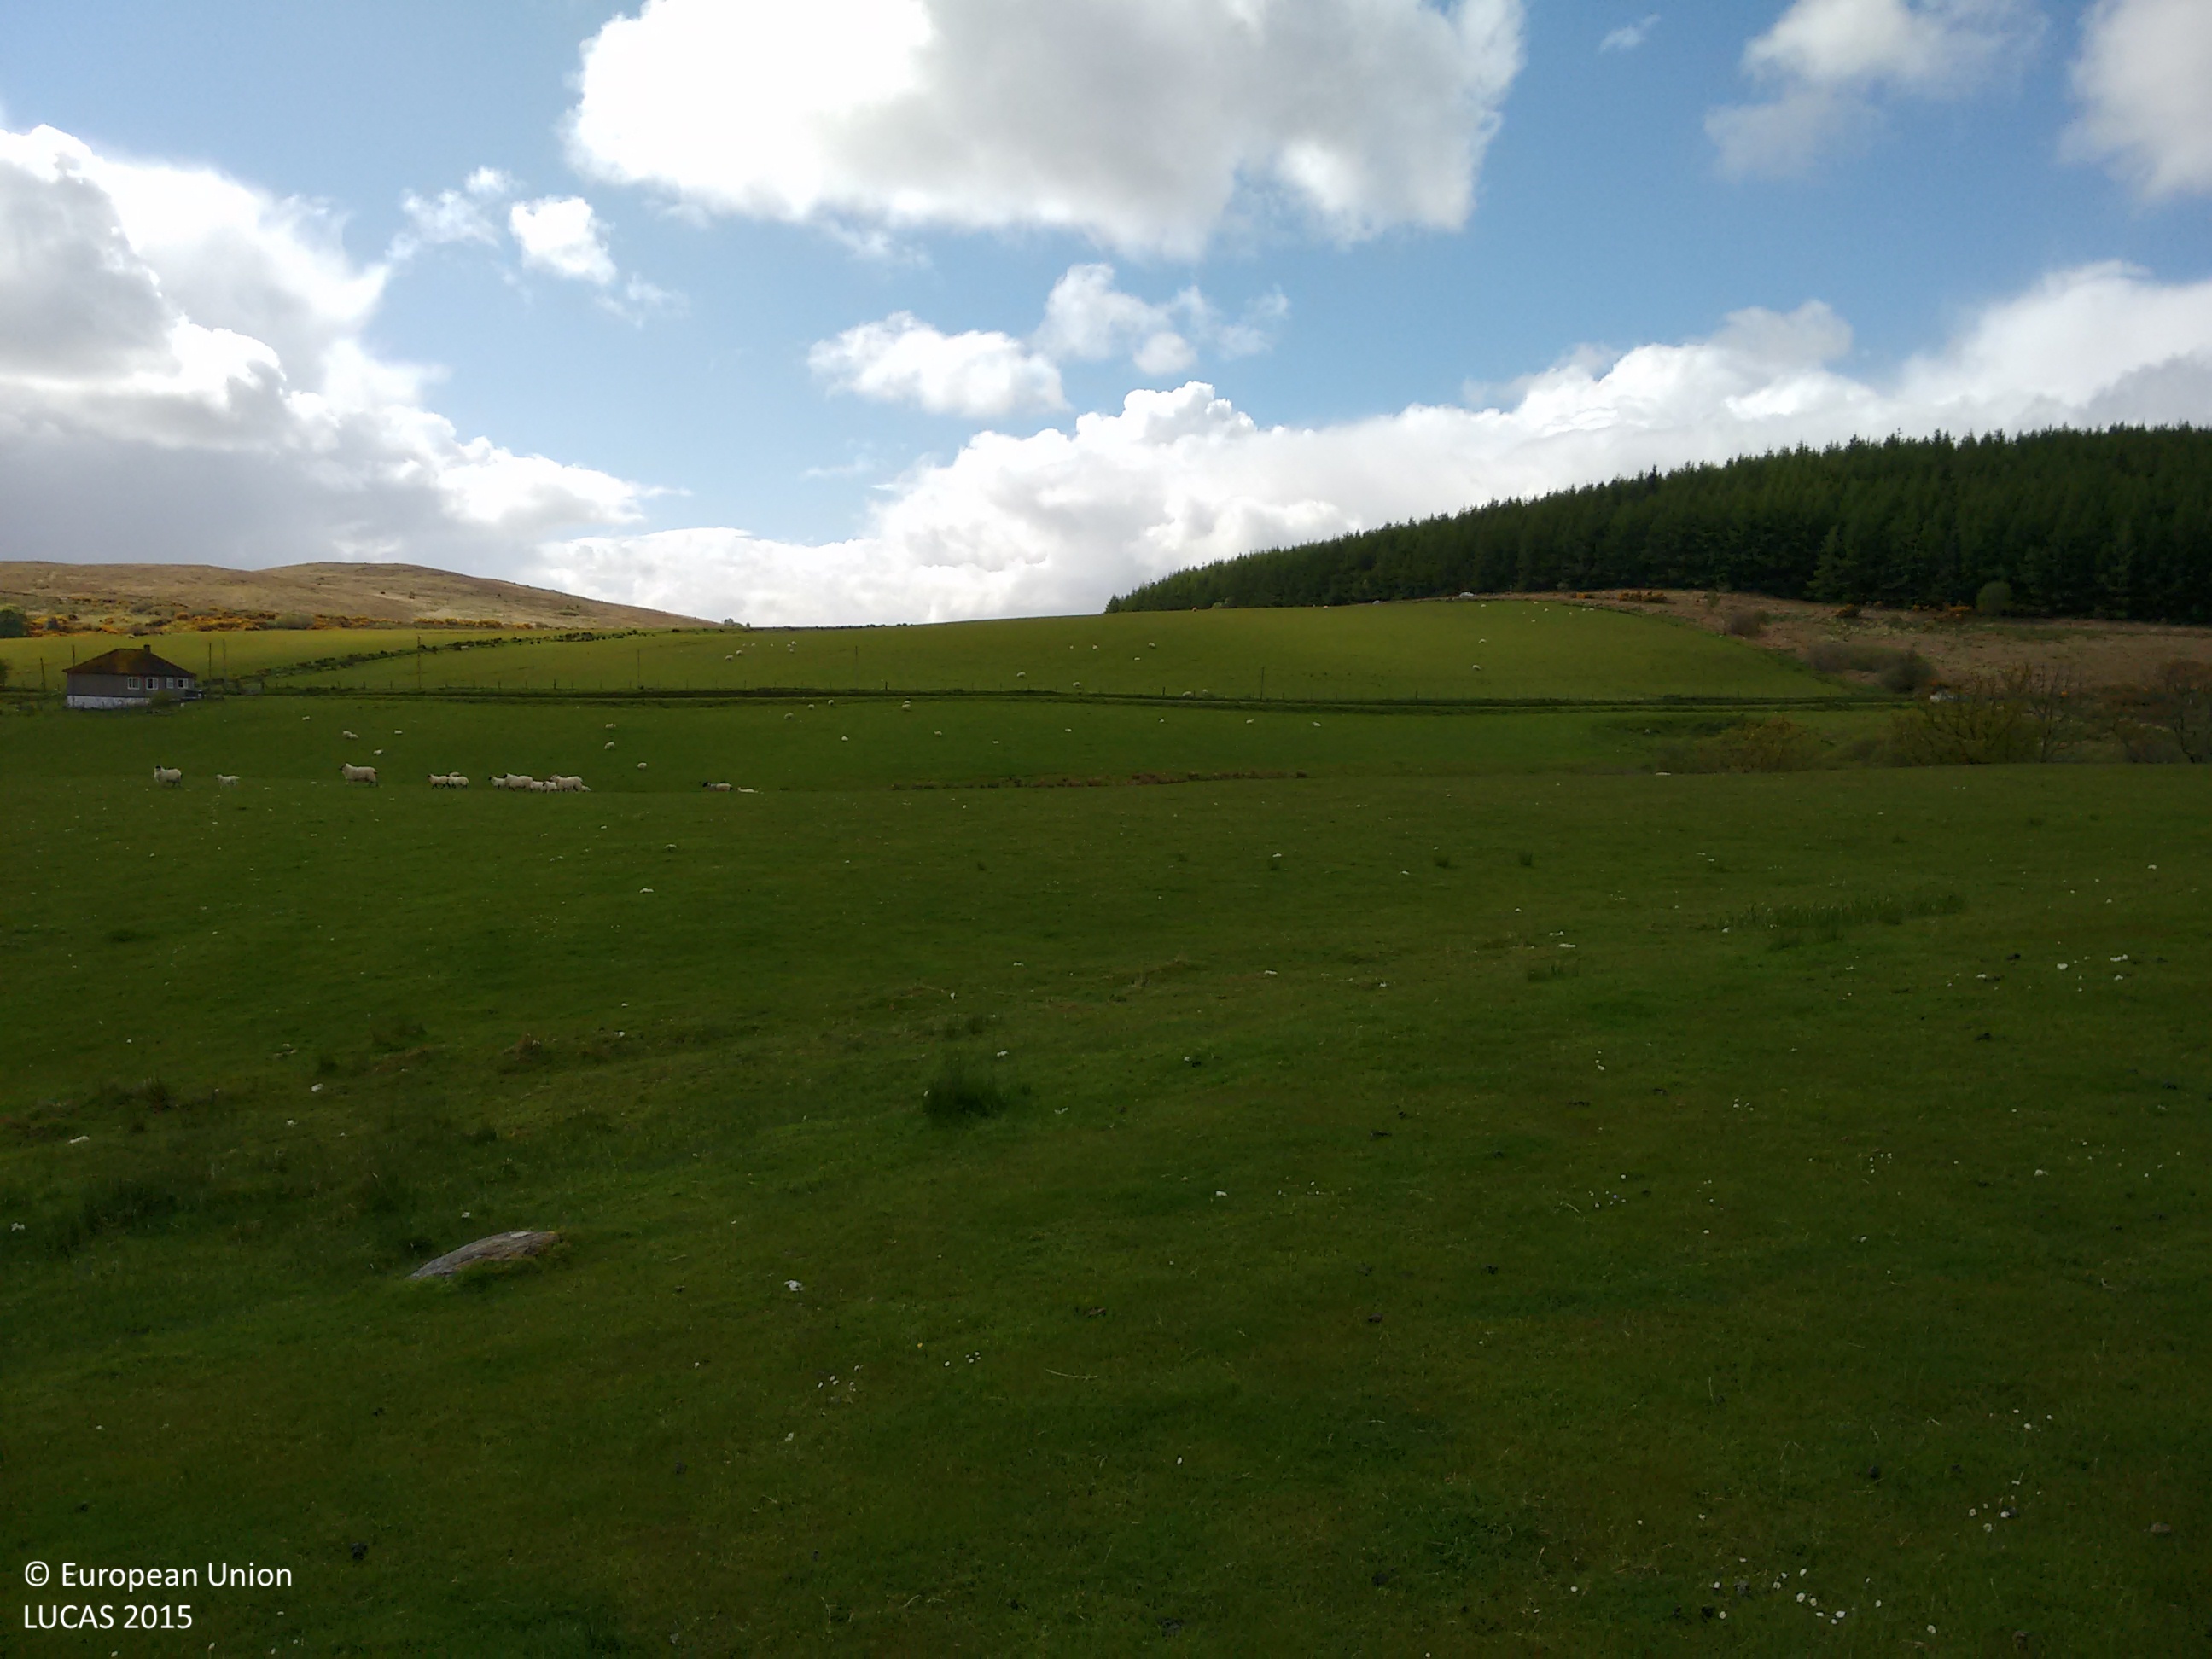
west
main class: Grassland
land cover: Grassland without tree/shrub cover
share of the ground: > 75 %
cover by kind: herbaceous plants 100 %
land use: Agriculture (excluding fallow land and kitchen gardens)
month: May
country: GB
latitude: 55.8695
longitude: -5.2832
